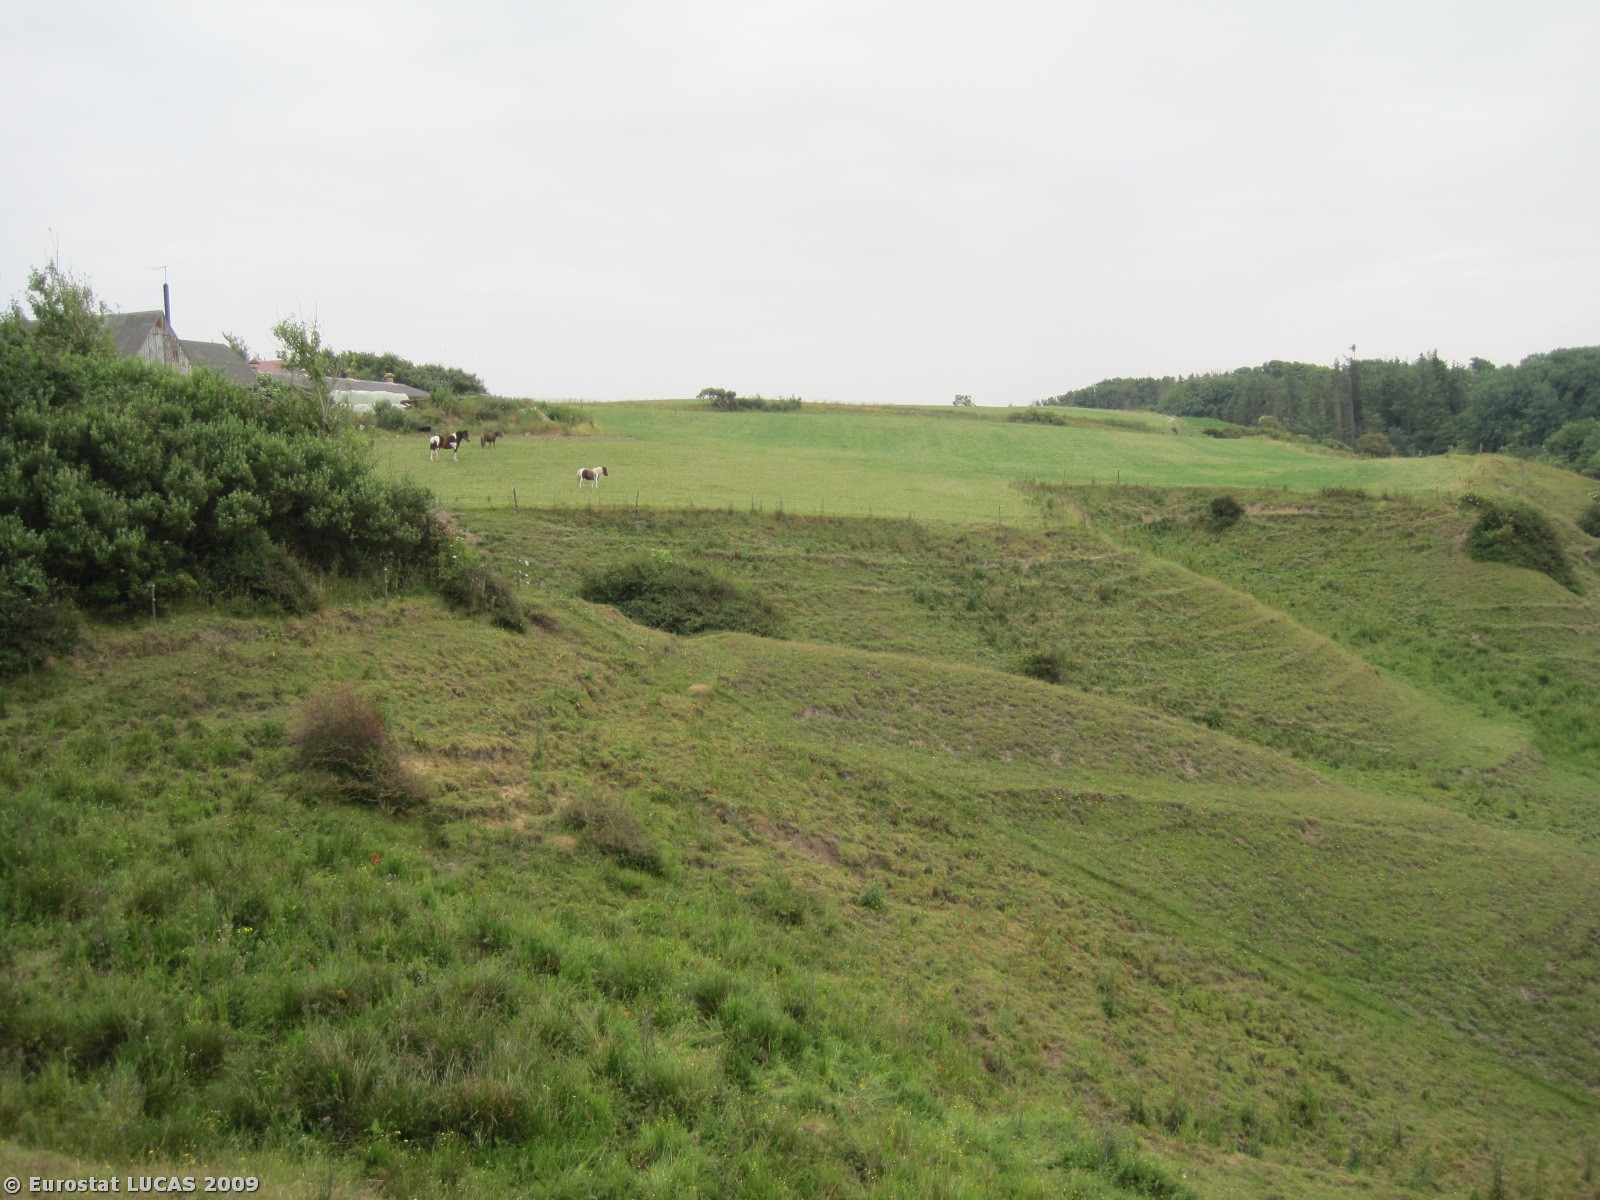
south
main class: Grassland
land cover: Grassland with sparse tree/shrub cover
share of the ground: > 75 %
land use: Agriculture (excluding fallow land and kitchen gardens)
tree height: < 5 m
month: June
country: DK
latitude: 56.5365
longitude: 8.3272
